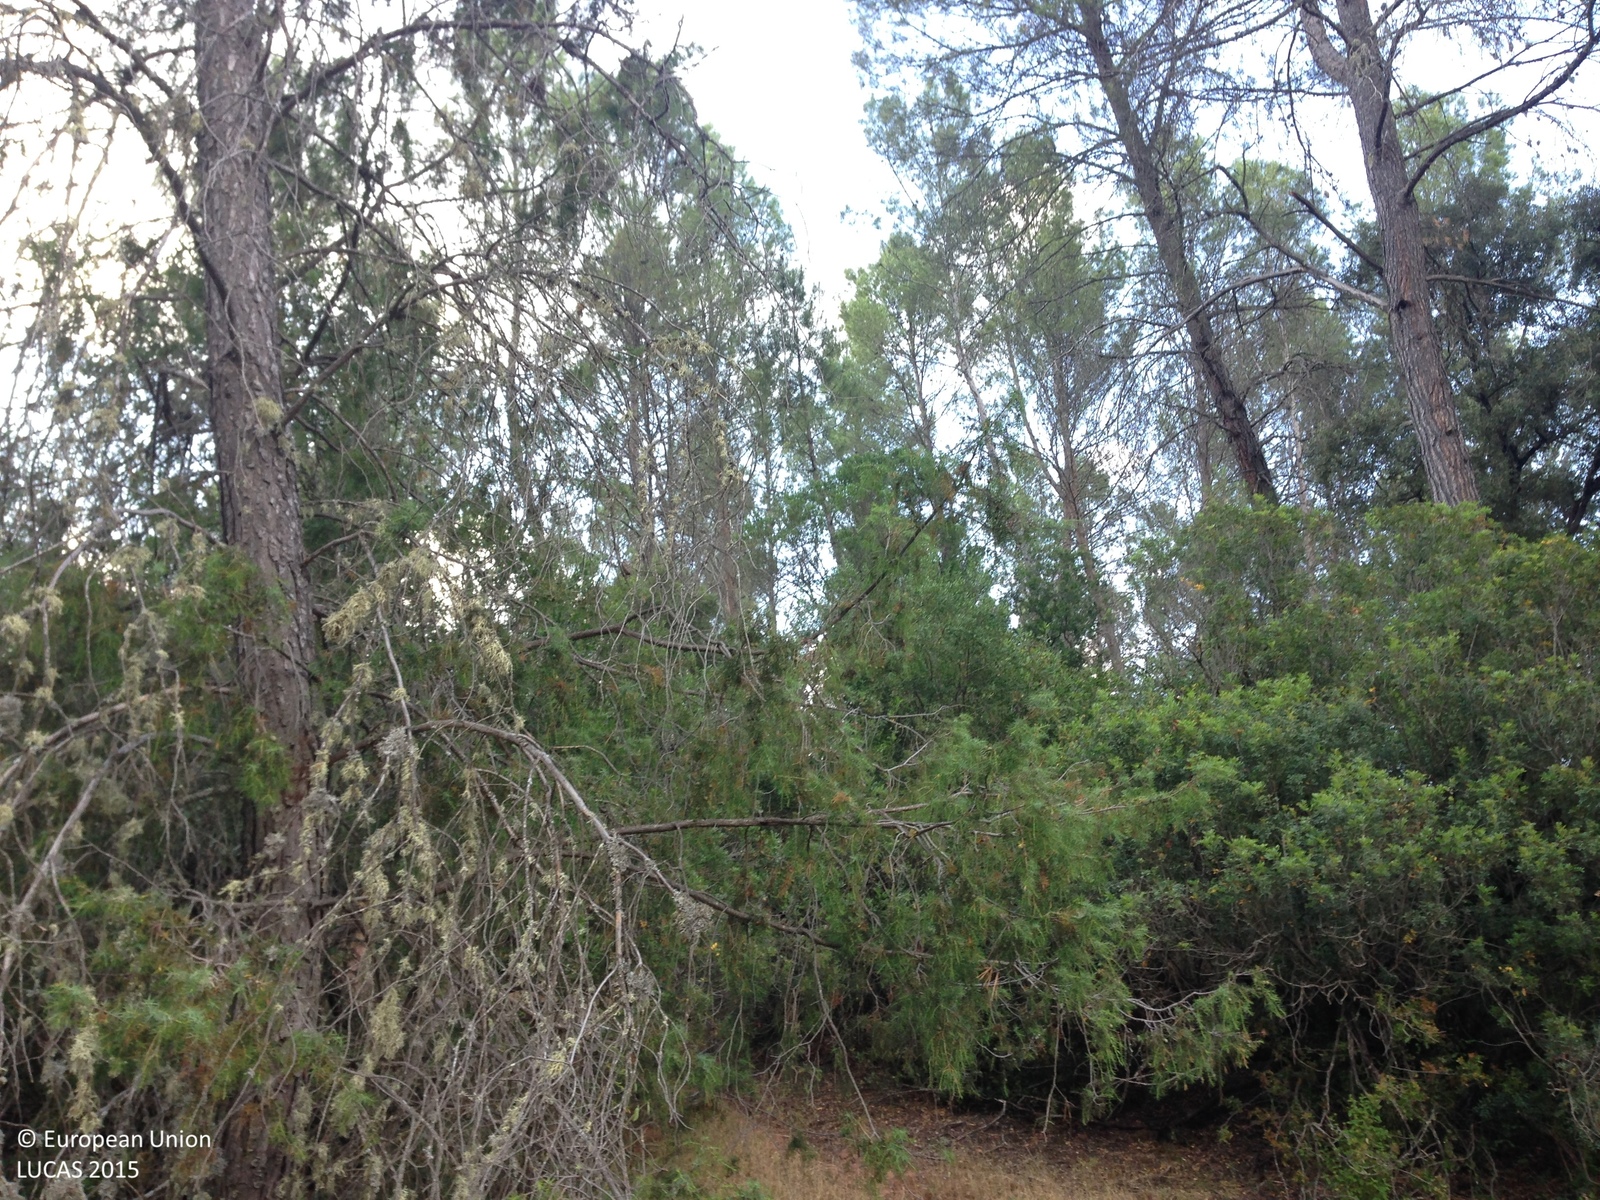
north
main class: Woodland
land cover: Pine dominated coniferous woodland
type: coniferous forest of the mediterranean region
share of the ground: > 75 %
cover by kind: coniferous forest trees 100 %
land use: Forestry
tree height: > 5 m
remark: Clear cut
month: June
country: ES
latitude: 38.0468
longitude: -2.8380
